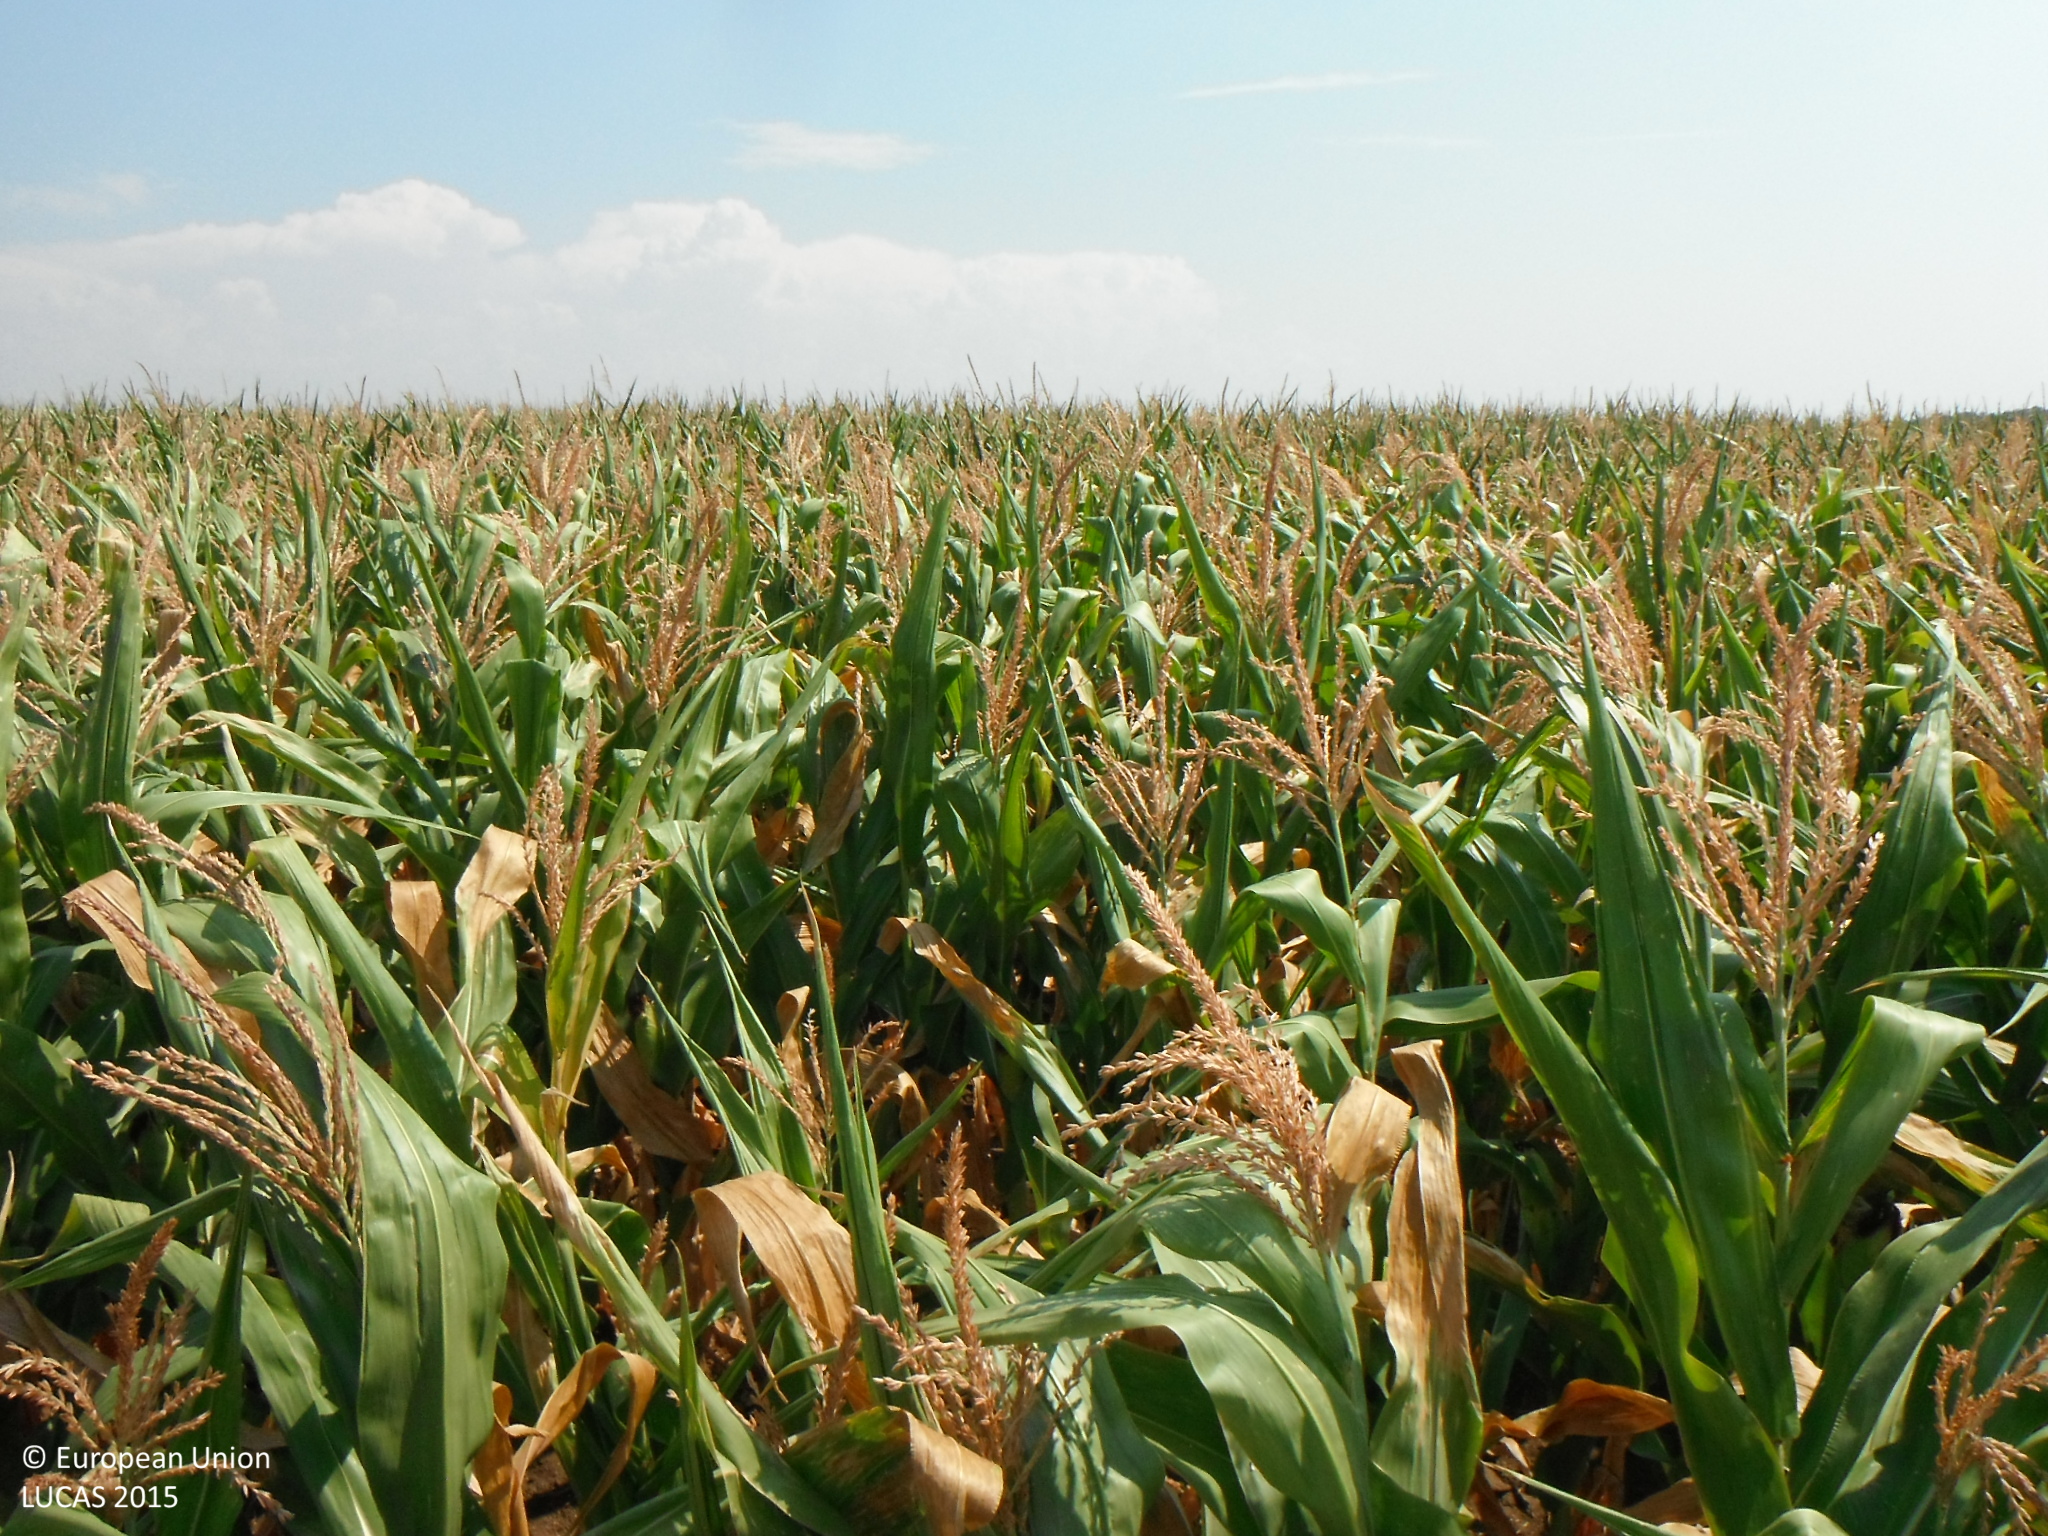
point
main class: Cropland
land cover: Maize
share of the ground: > 75 %
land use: Agriculture (excluding fallow land and kitchen gardens)
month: August
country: SK
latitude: 47.9840
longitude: 18.2808
